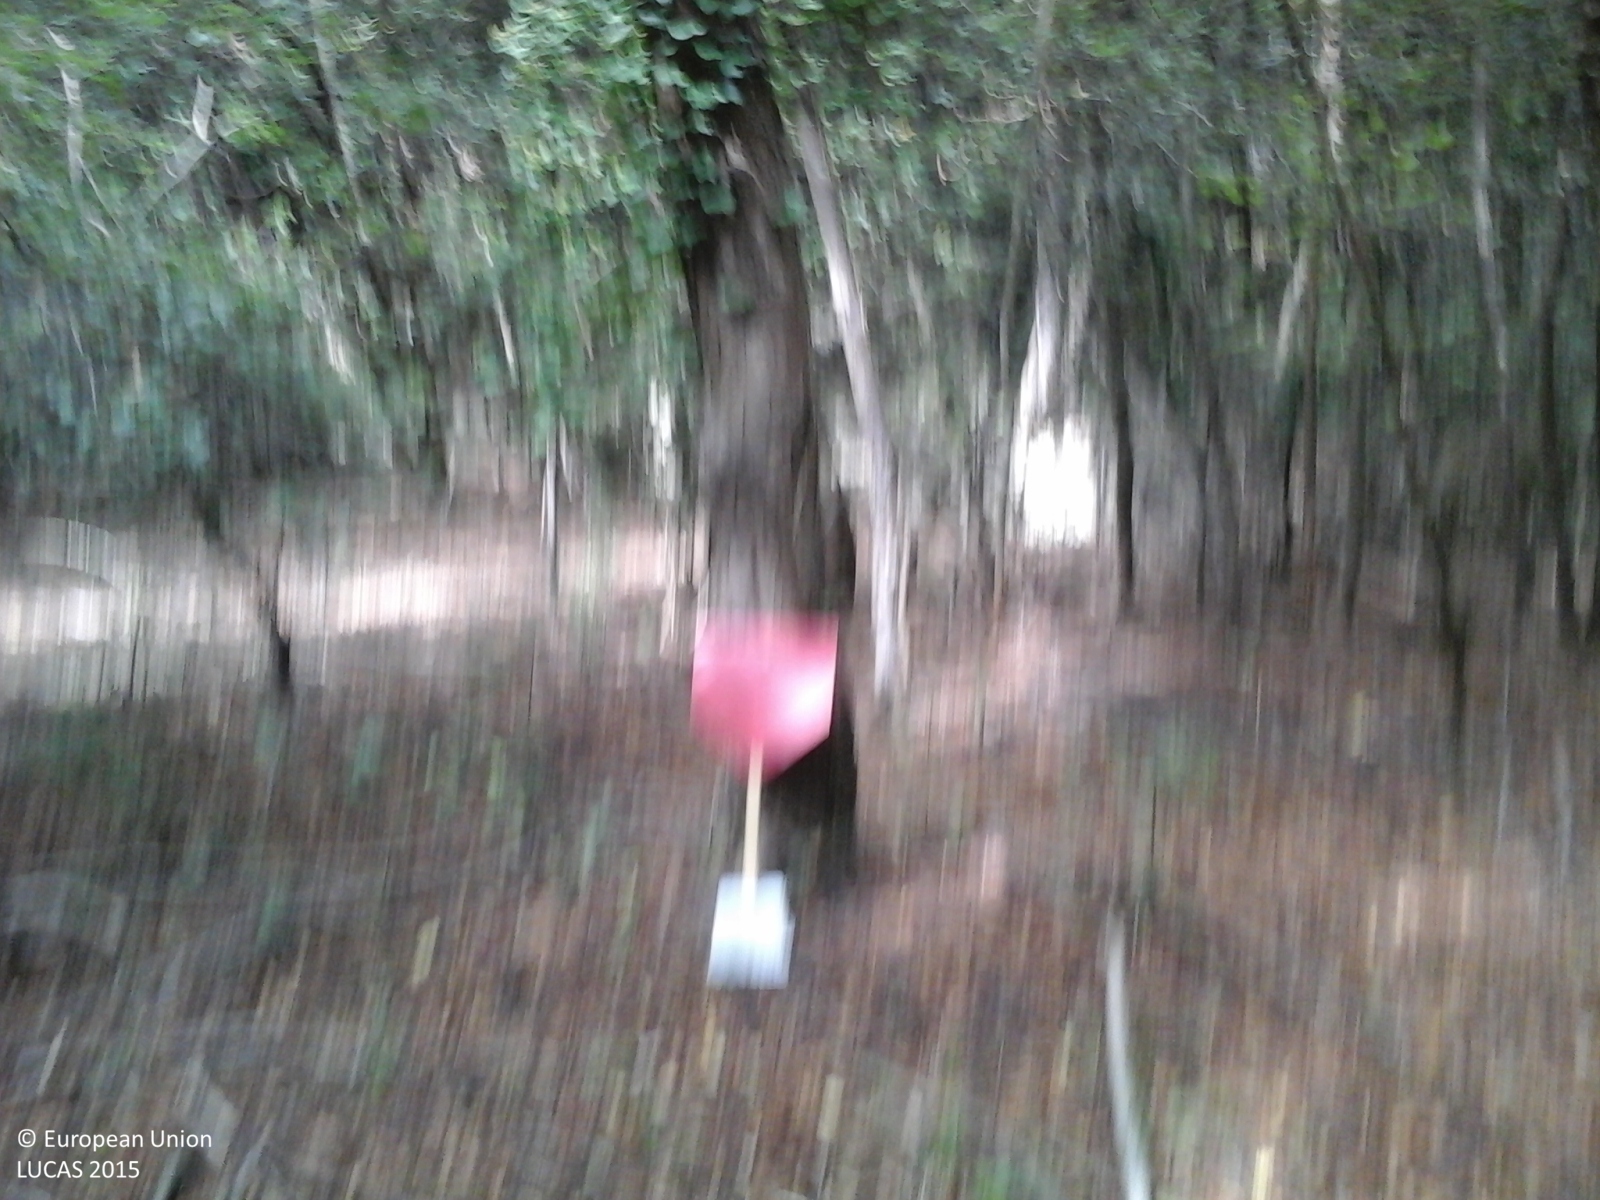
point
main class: Woodland
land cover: Broadleaved woodland
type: thermophilous deciduous forest
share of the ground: > 75 %
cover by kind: broadleaved forest trees 100 %
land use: Semi-natural and natural areas not in use
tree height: > 5 m
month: September
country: IT
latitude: 44.1930
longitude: 8.3398
